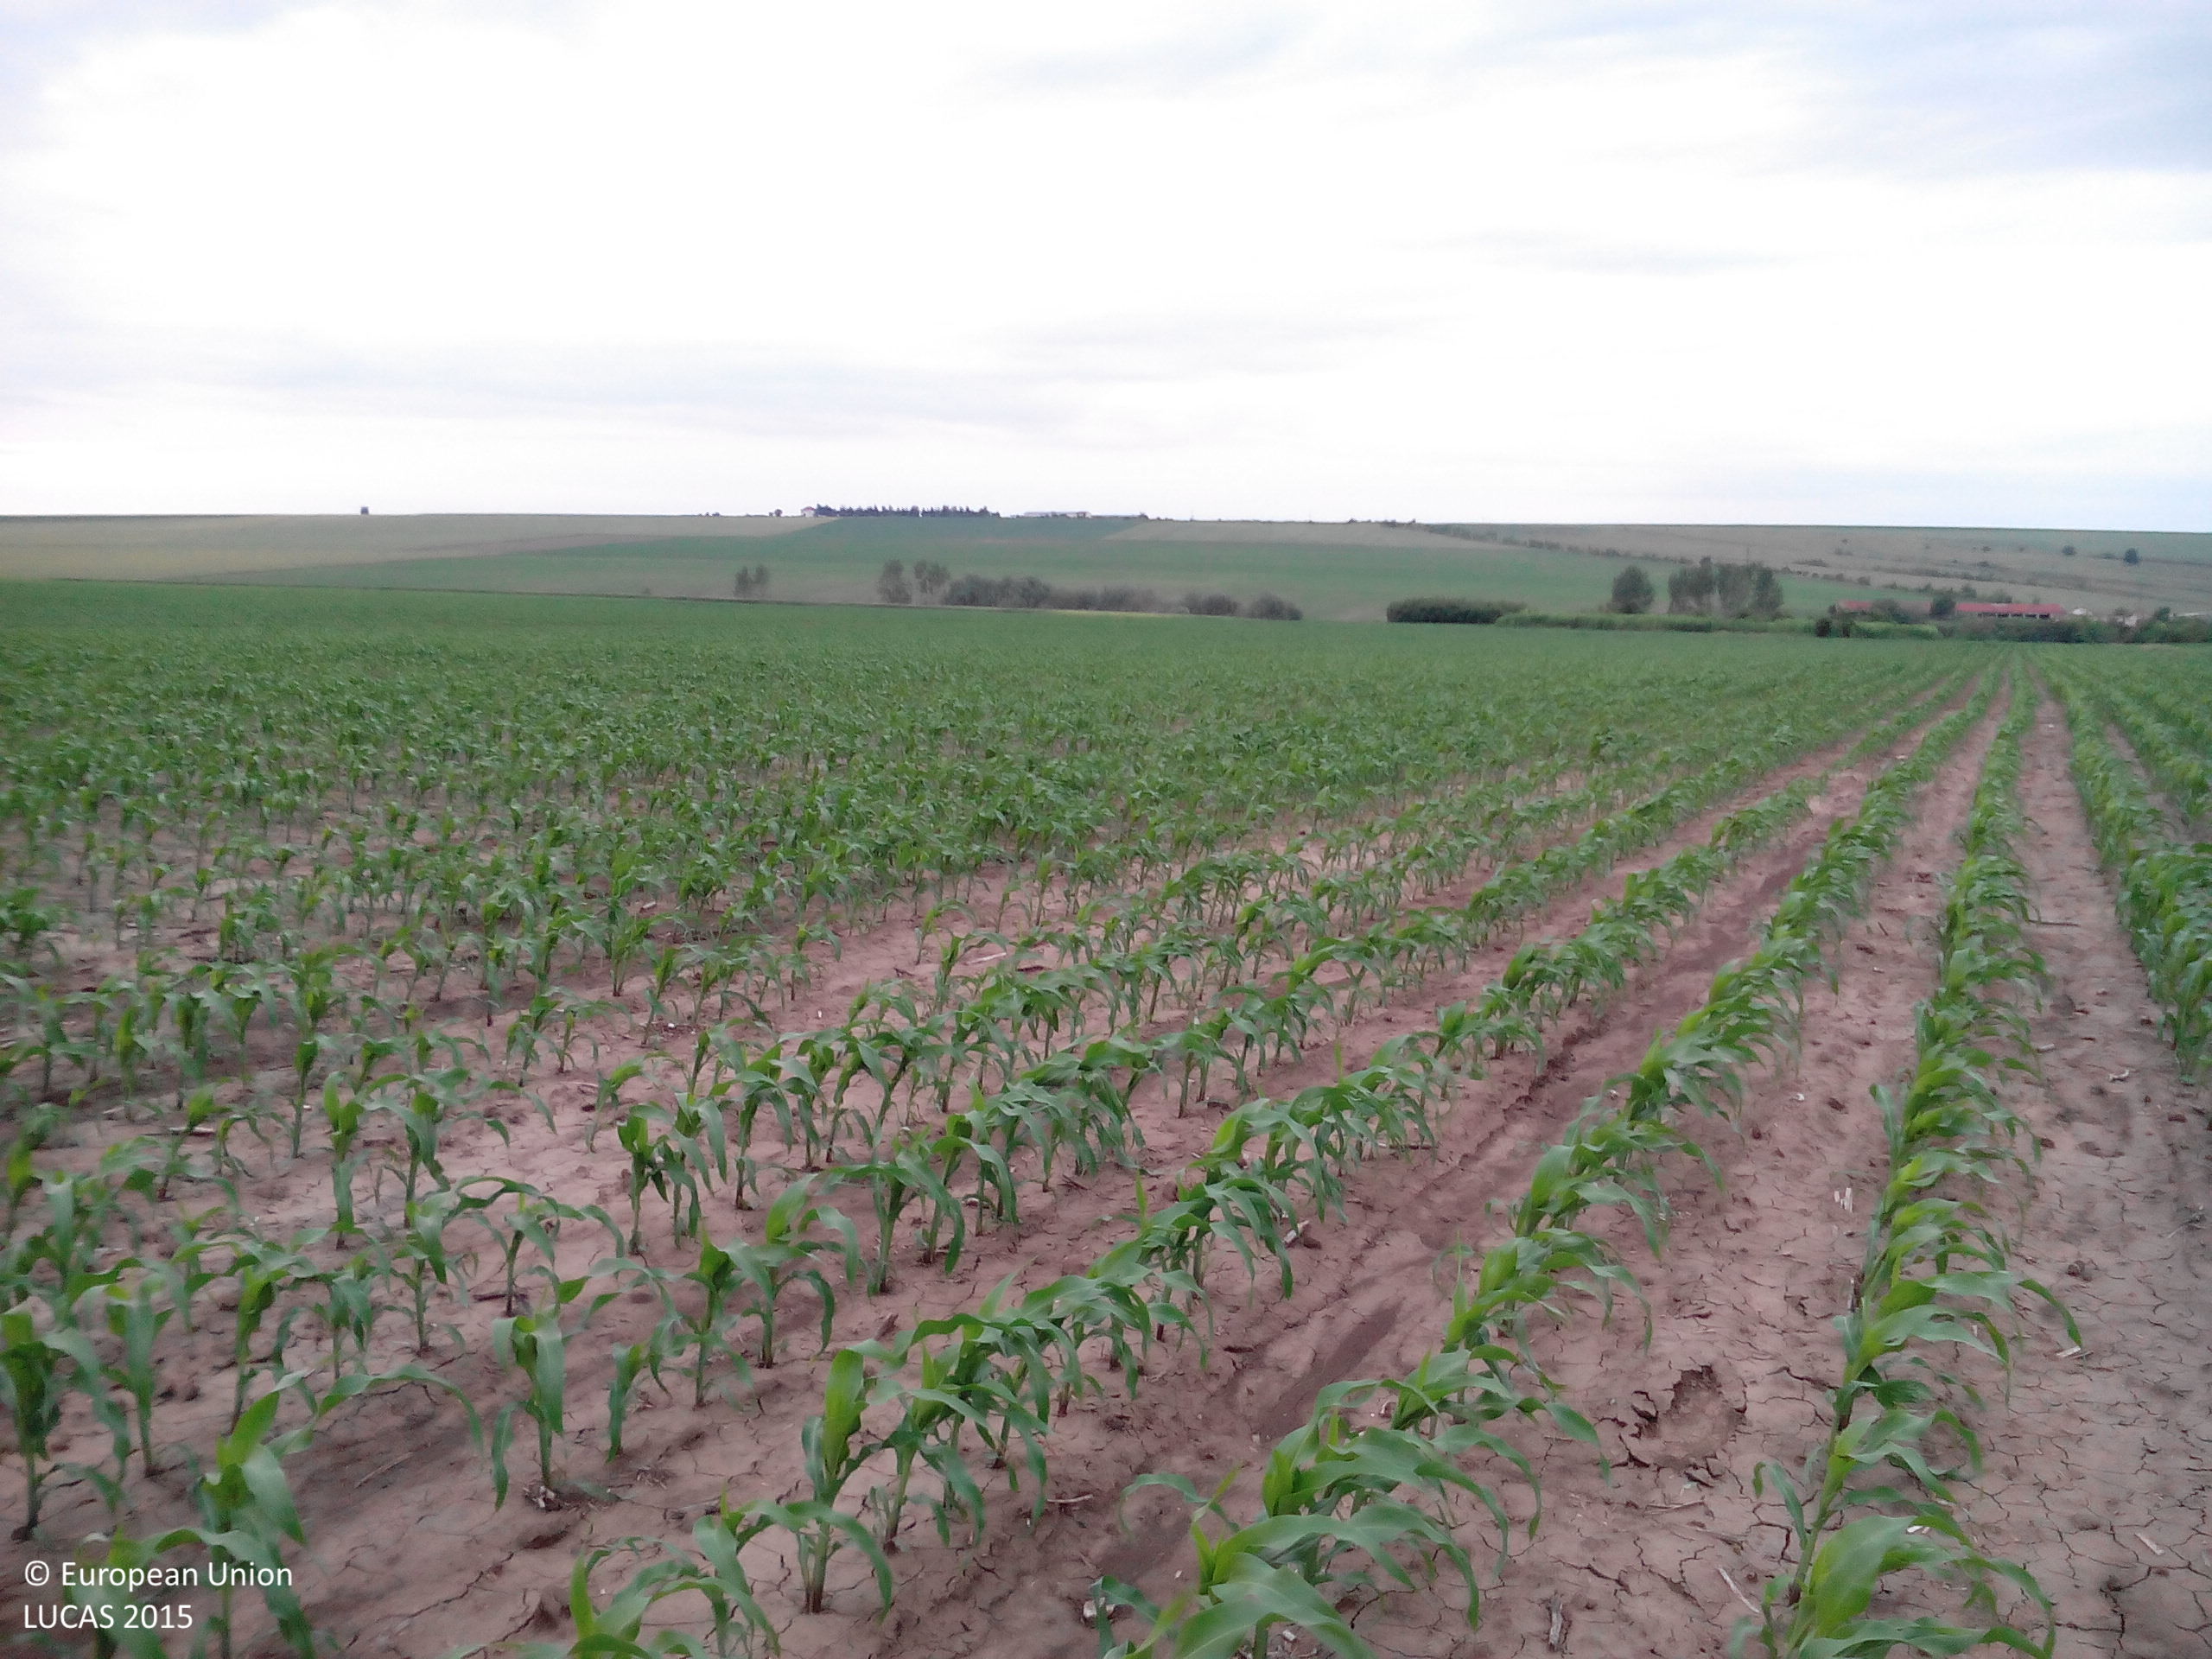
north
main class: Cropland
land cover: Maize
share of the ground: 25 - 50 %
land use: Agriculture (excluding fallow land and kitchen gardens)
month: May
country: BG
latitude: 43.5287
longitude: 24.0985
